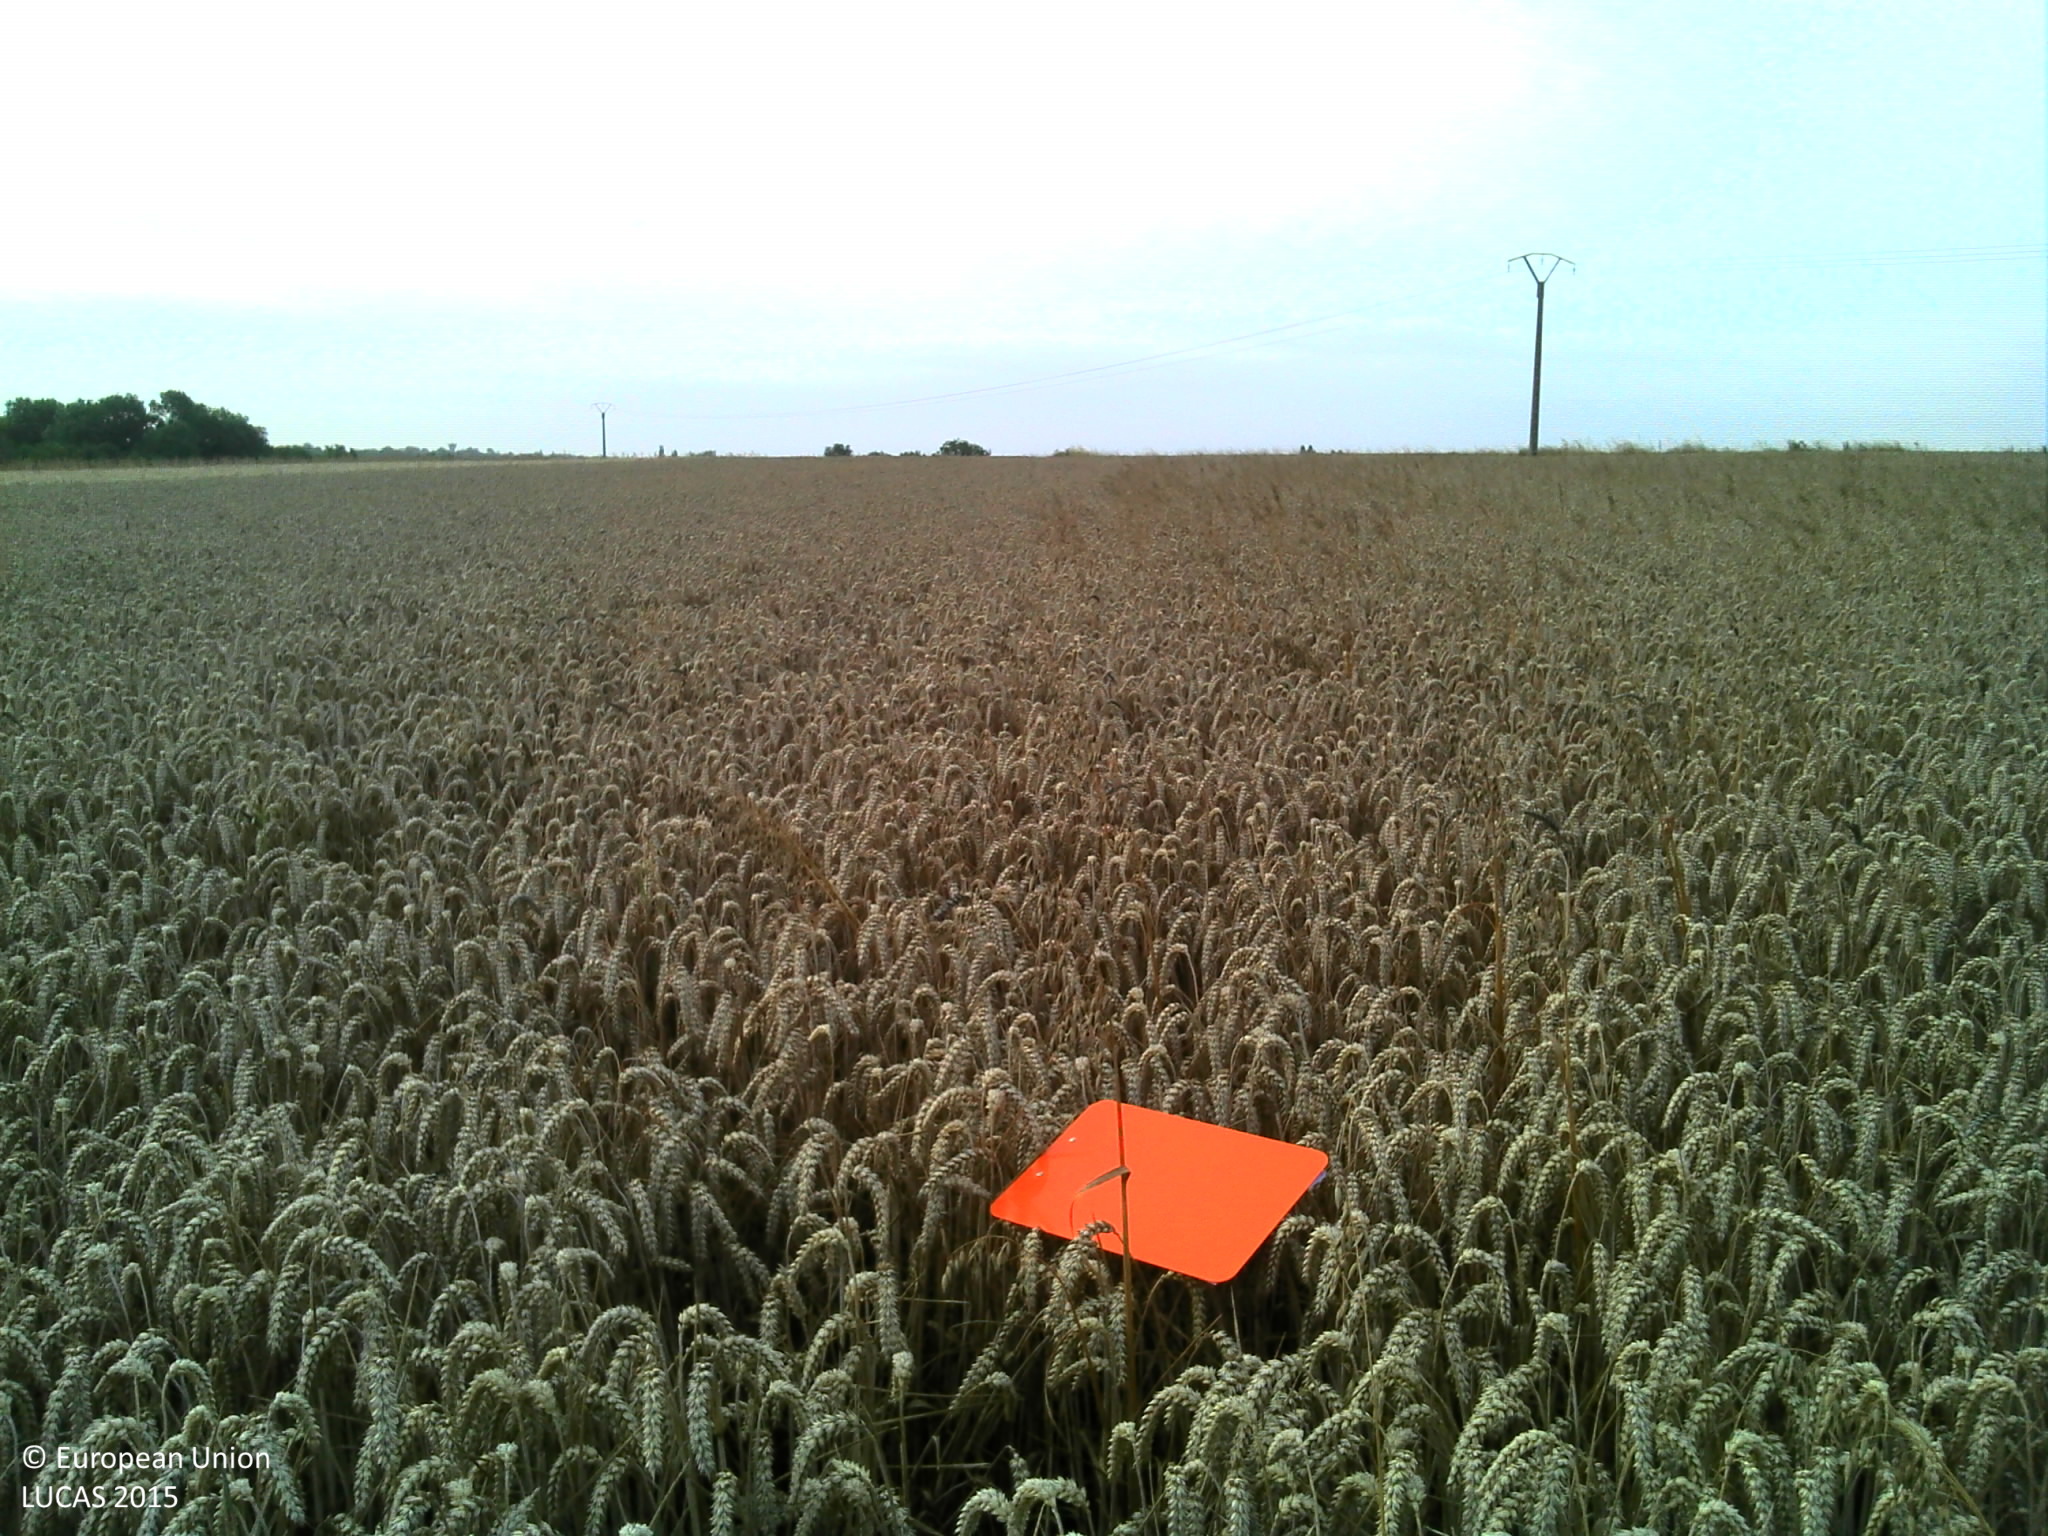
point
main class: Cropland
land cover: Common wheat
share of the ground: > 75 %
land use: Agriculture (excluding fallow land and kitchen gardens)
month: July
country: FR
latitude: 49.1971
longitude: -0.2298
